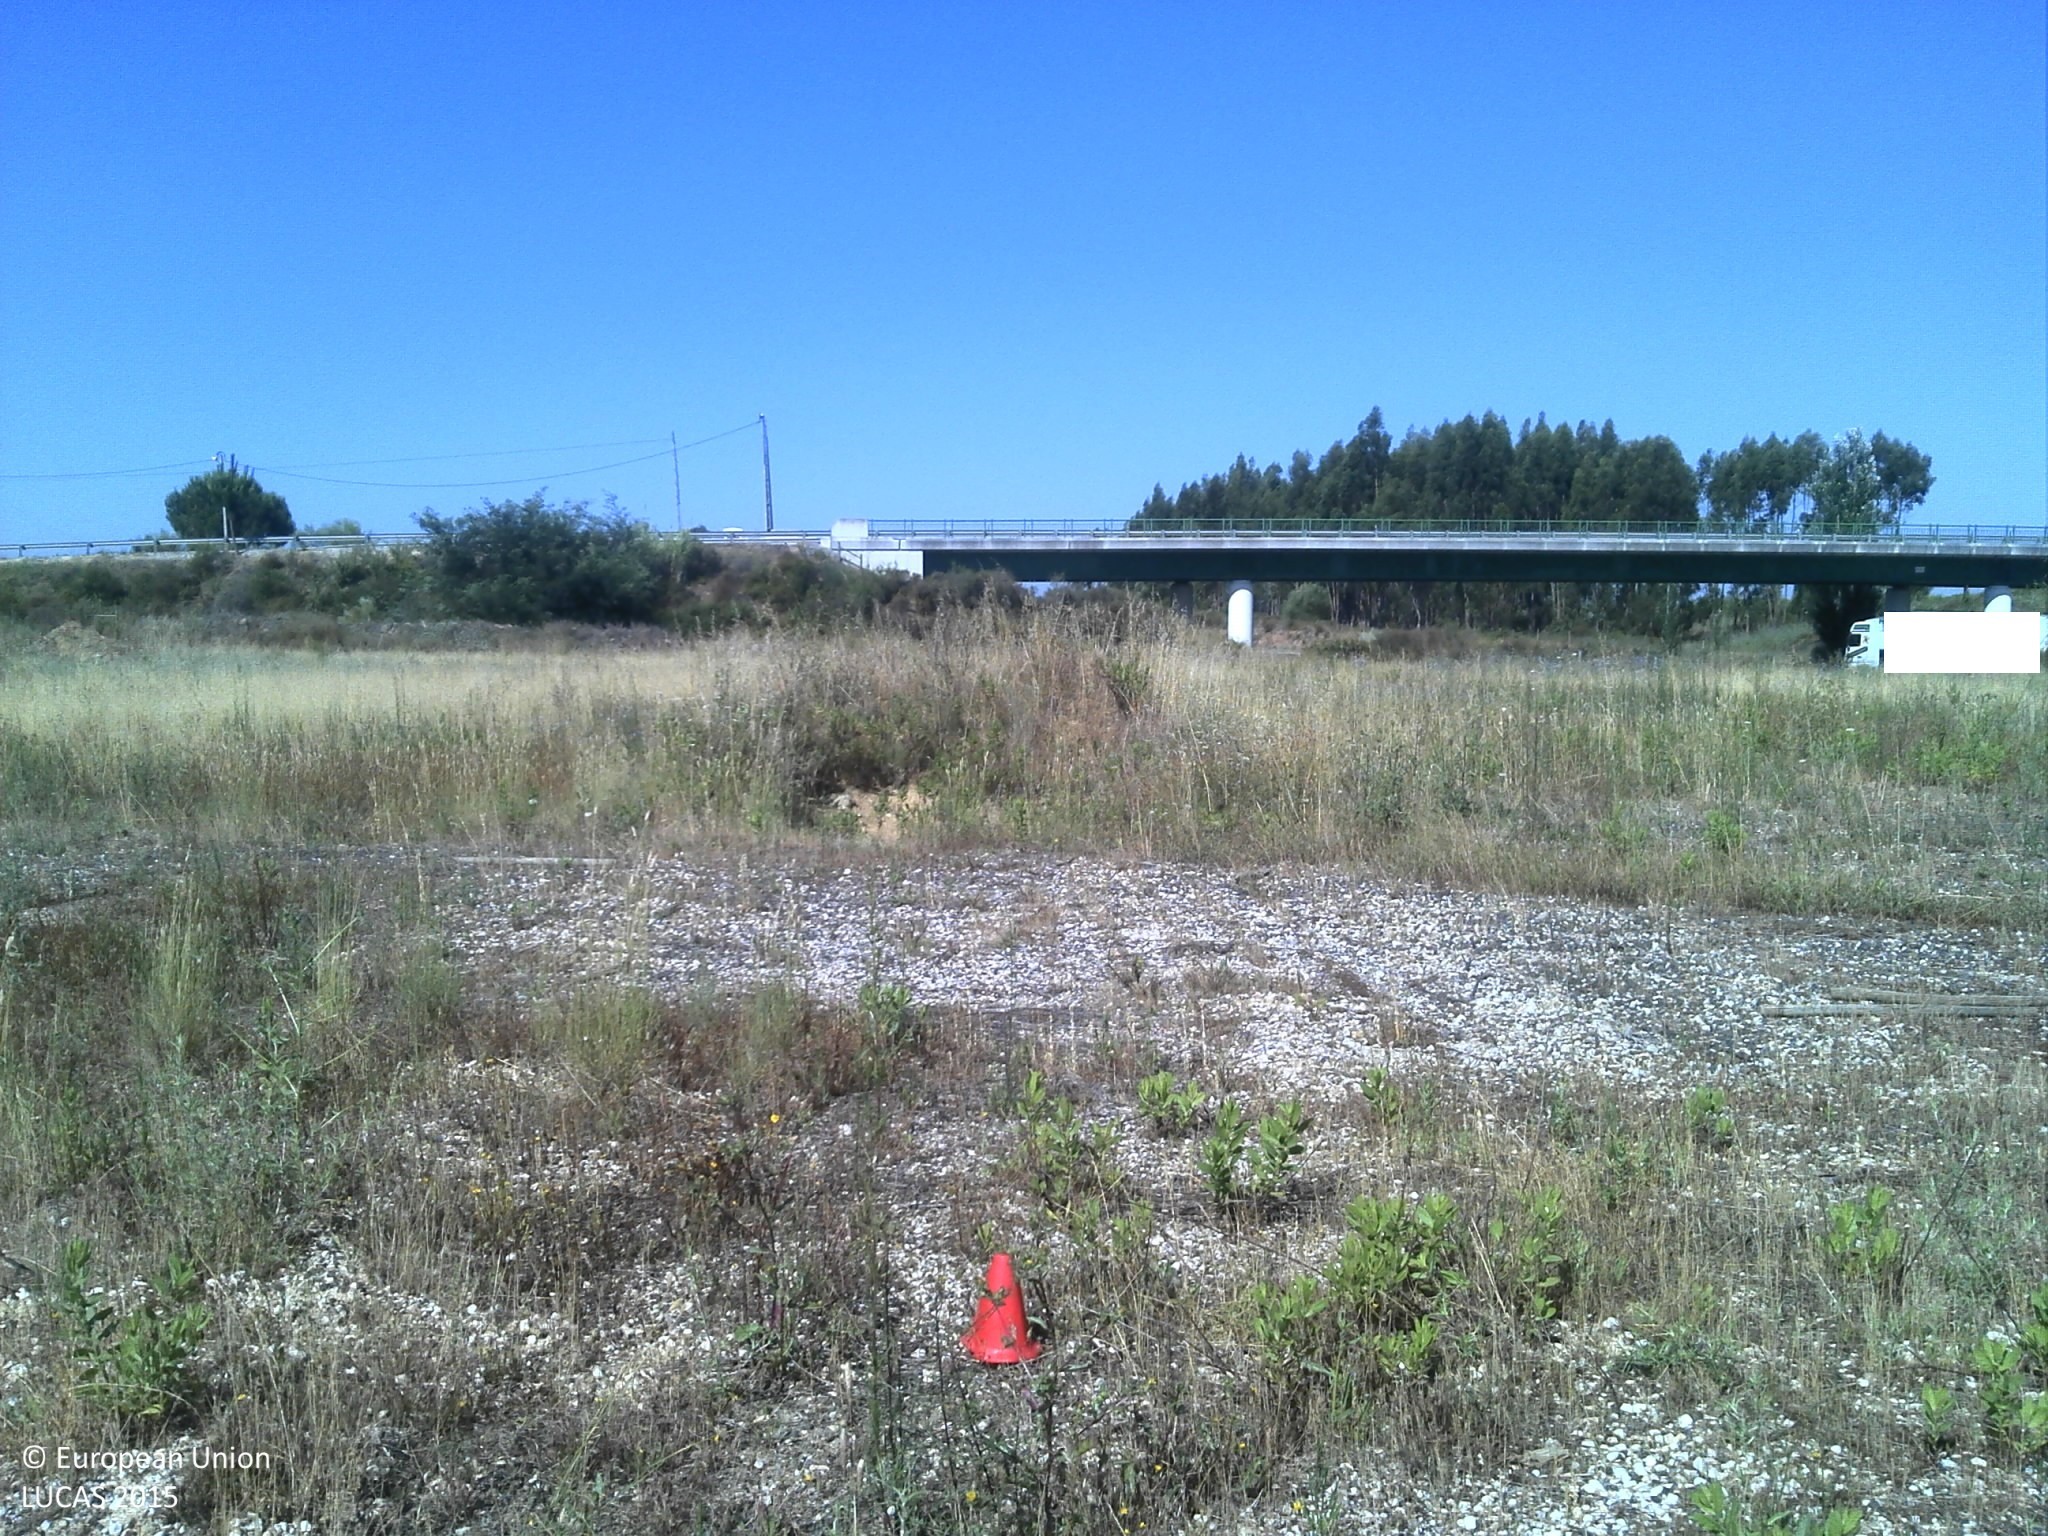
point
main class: Grassland
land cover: Spontaneously vegetated surfaces
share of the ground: 25 - 50 %
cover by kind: herbaceous plants 55 %, unconsolidated bare surface 40 %, shrubs 5 %
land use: Abandoned areas
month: June
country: PT
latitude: 39.2351
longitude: -8.7615
